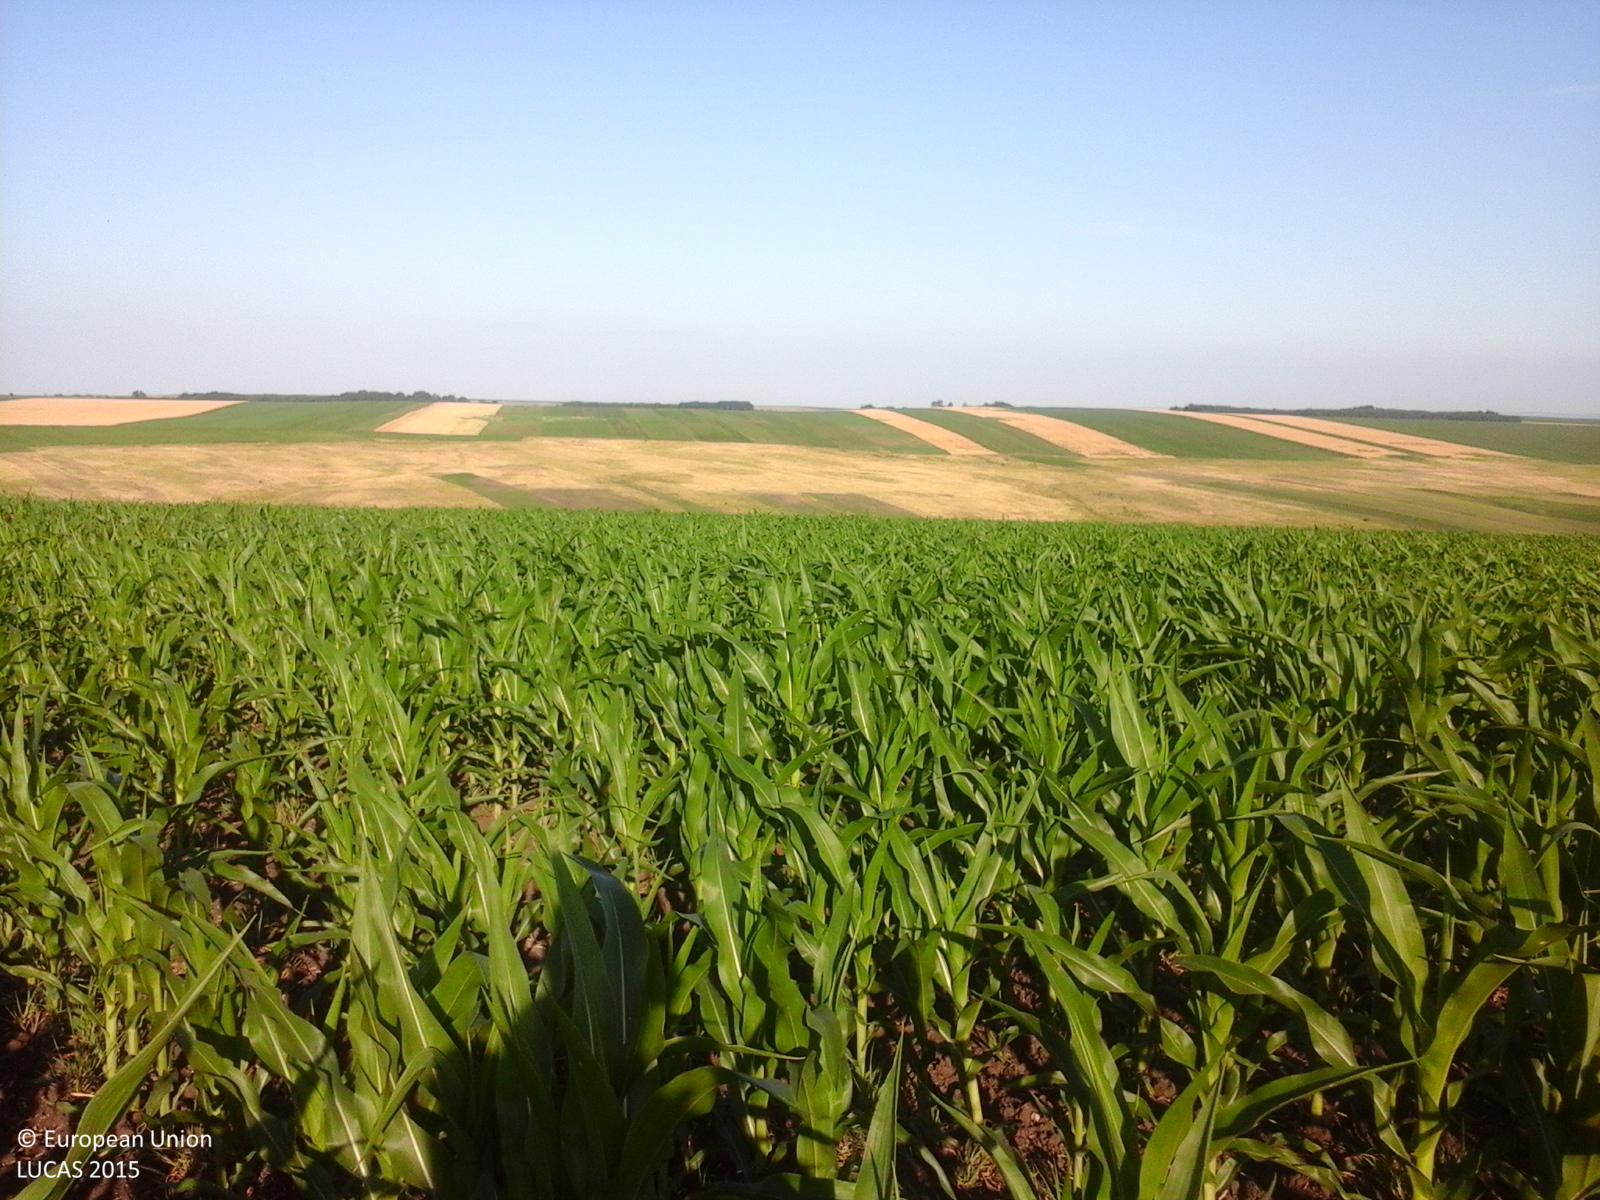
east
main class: Cropland
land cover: Maize
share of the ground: 50 - 75 %
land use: Agriculture (excluding fallow land and kitchen gardens)
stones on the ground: < 10 %
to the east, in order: Maize
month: June
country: RO
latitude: 47.3199
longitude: 27.1875
